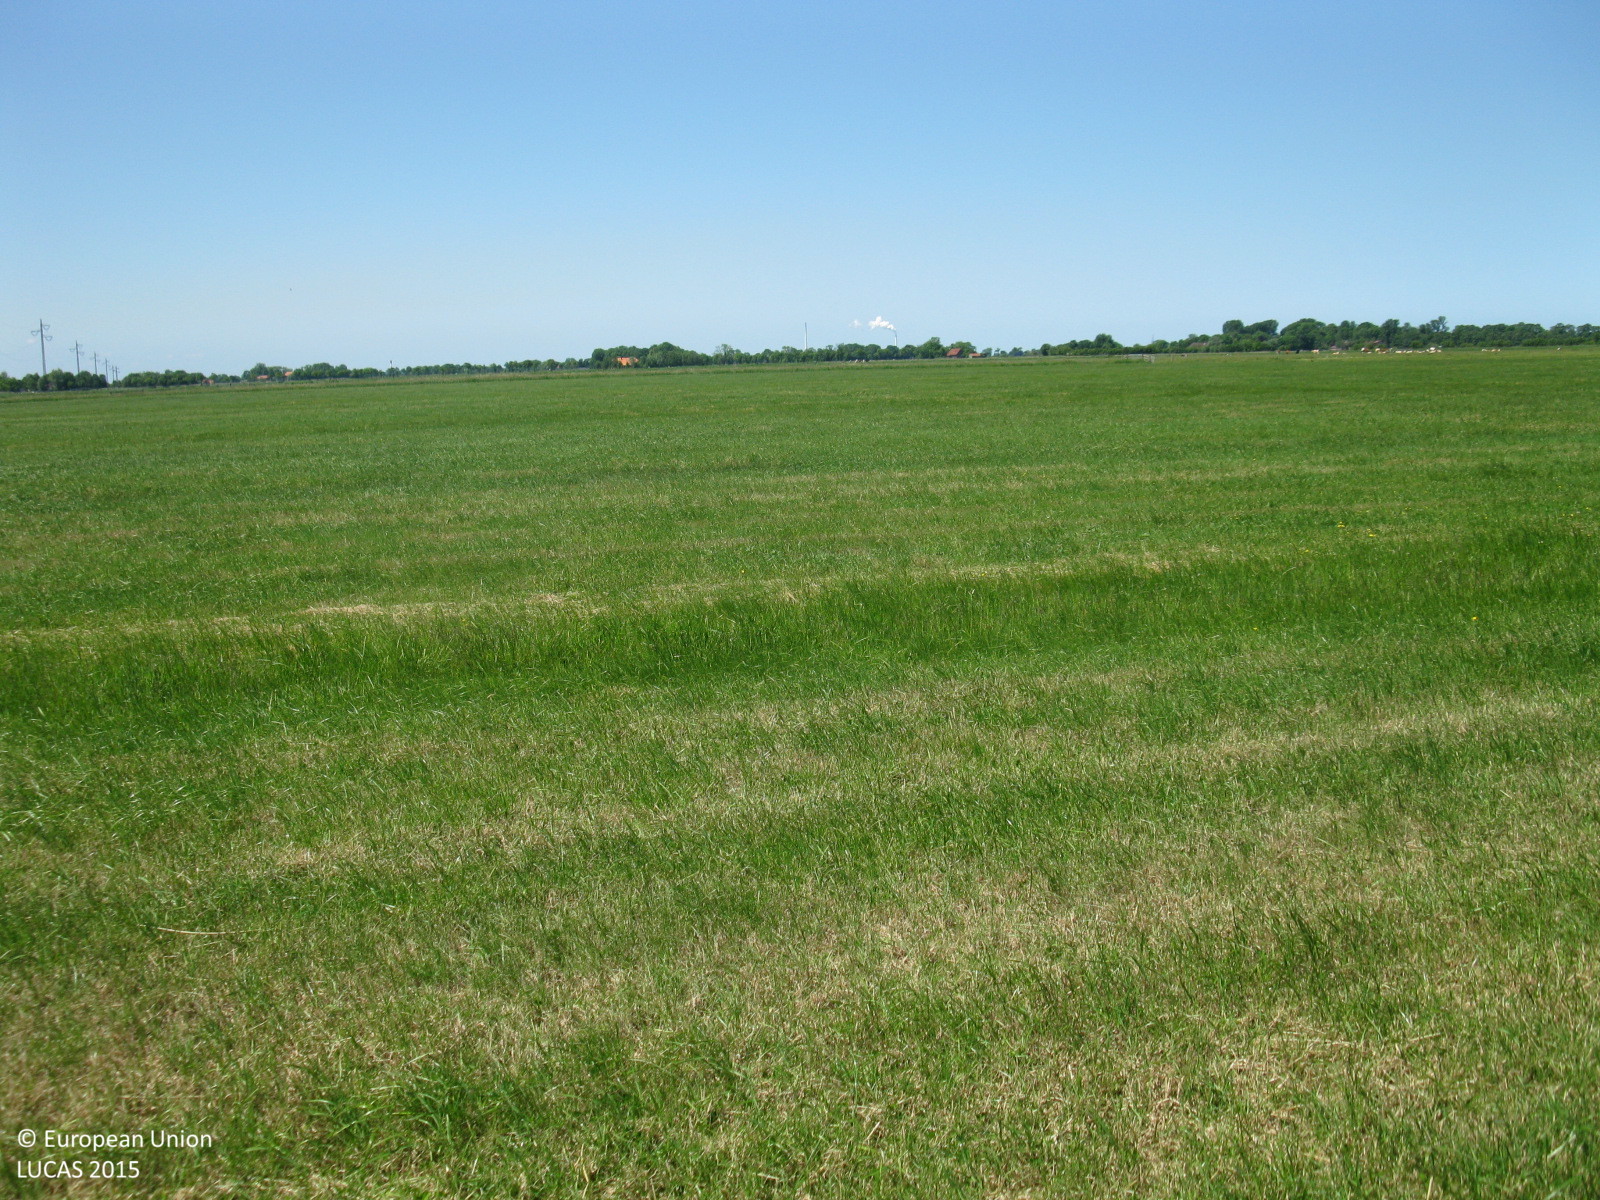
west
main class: Grassland
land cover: Grassland without tree/shrub cover
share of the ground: > 75 %
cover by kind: herbaceous plants 100 %
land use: Agriculture (excluding fallow land and kitchen gardens)
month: June
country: DE
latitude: 53.5521
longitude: 8.3253
